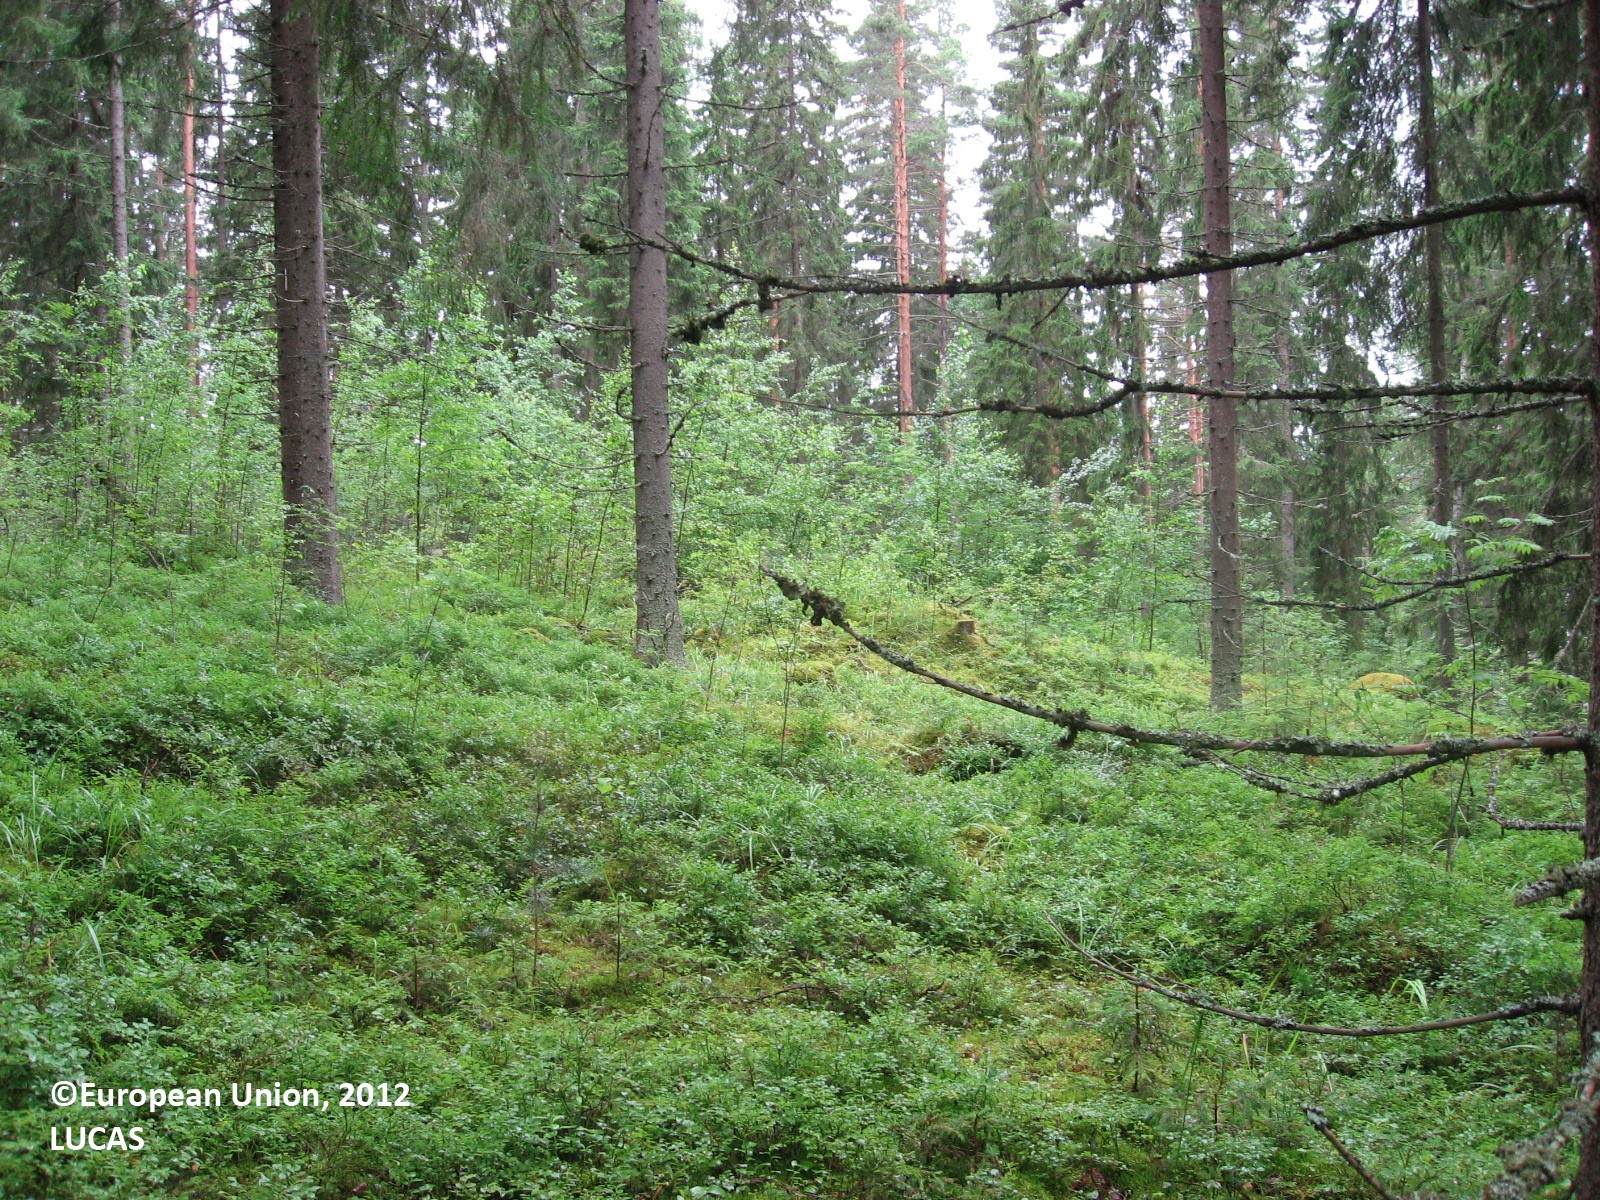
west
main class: Woodland
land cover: Spruce dominated coniferous woodland
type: boreal forest
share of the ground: 50 - 75 %
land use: Forestry
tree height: > 5 m
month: July
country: FI
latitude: 61.2271
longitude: 25.8700
